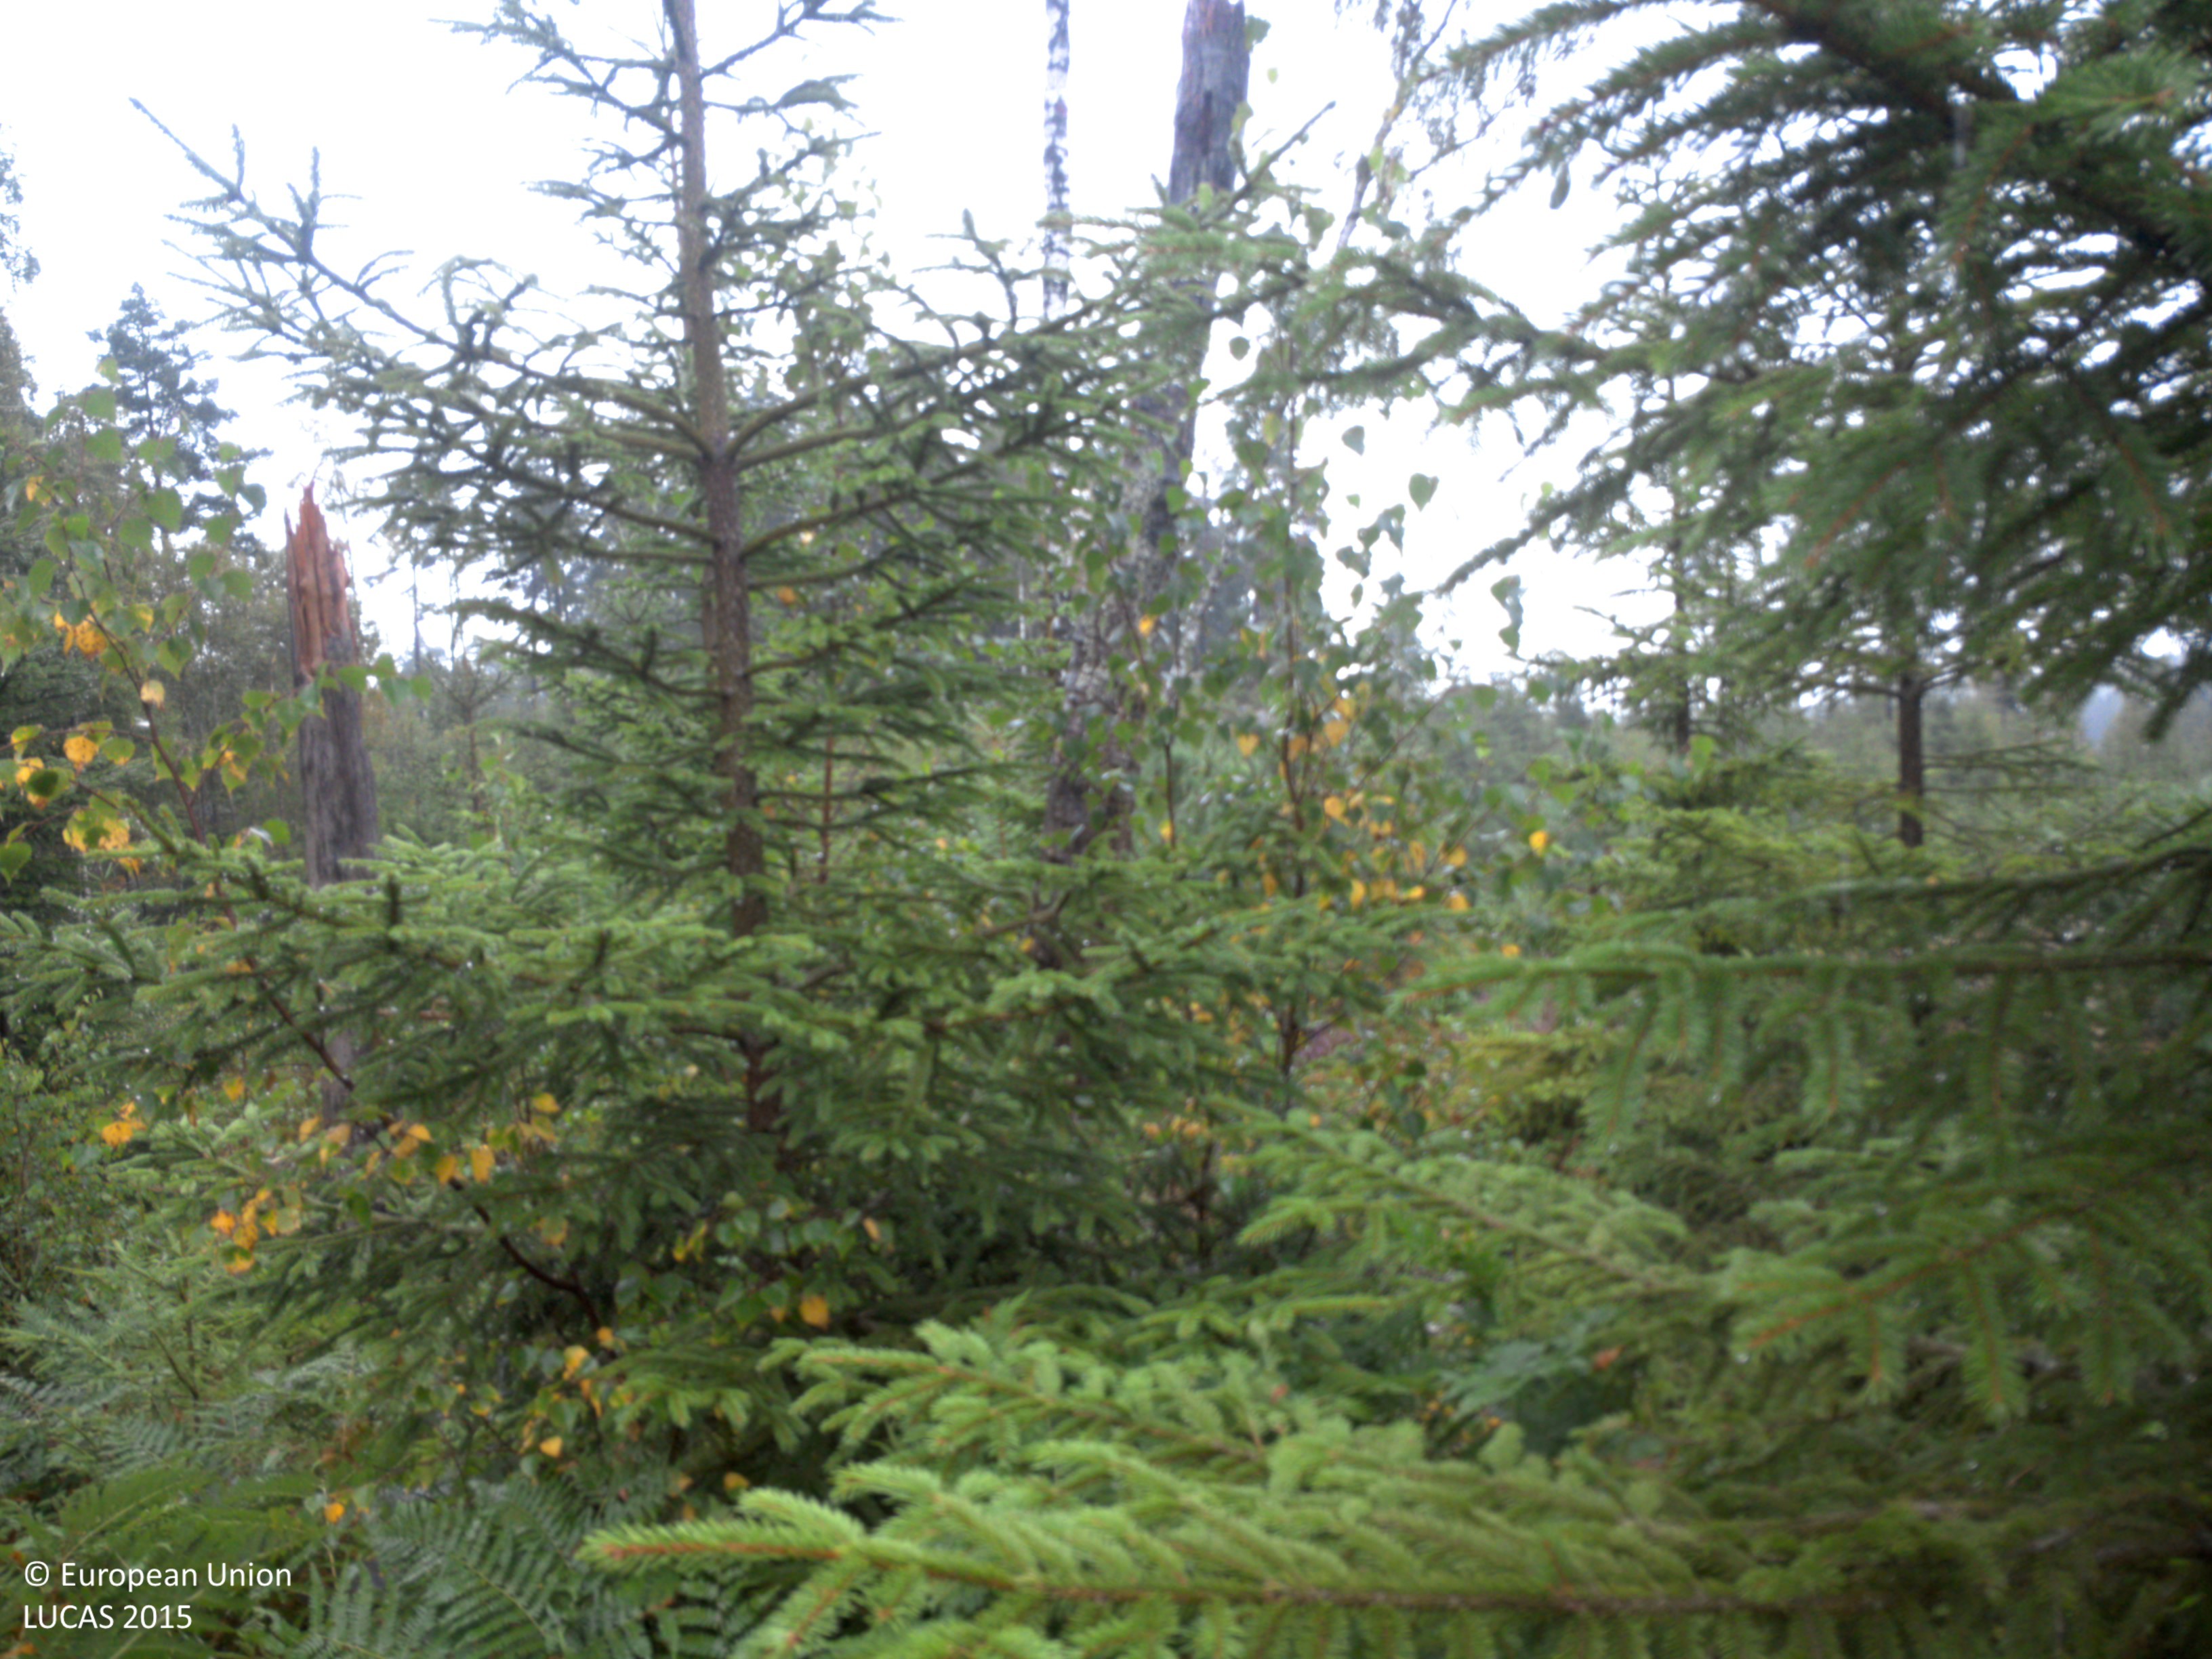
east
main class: Woodland
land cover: Spruce dominated mixed woodland
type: boreal forest
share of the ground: 50 - 75 %
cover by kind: coniferous forest trees 50 %, broadleaved forest trees 20 %, shrubs 15 %, herbaceous plants 10 %, lichens and mosses 5 %
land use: Forestry
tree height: < 5 m
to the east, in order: Spruce dominated mixed woodland; Pine dominated mixed woodland; Spruce dominated mixed woodland; Paved roads, cycling and walking lanes; Spruce dominated coniferous woodland; Rivers and streams; Spruce dominated coniferous woodland
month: August
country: SE
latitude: 58.0735
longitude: 12.3185
